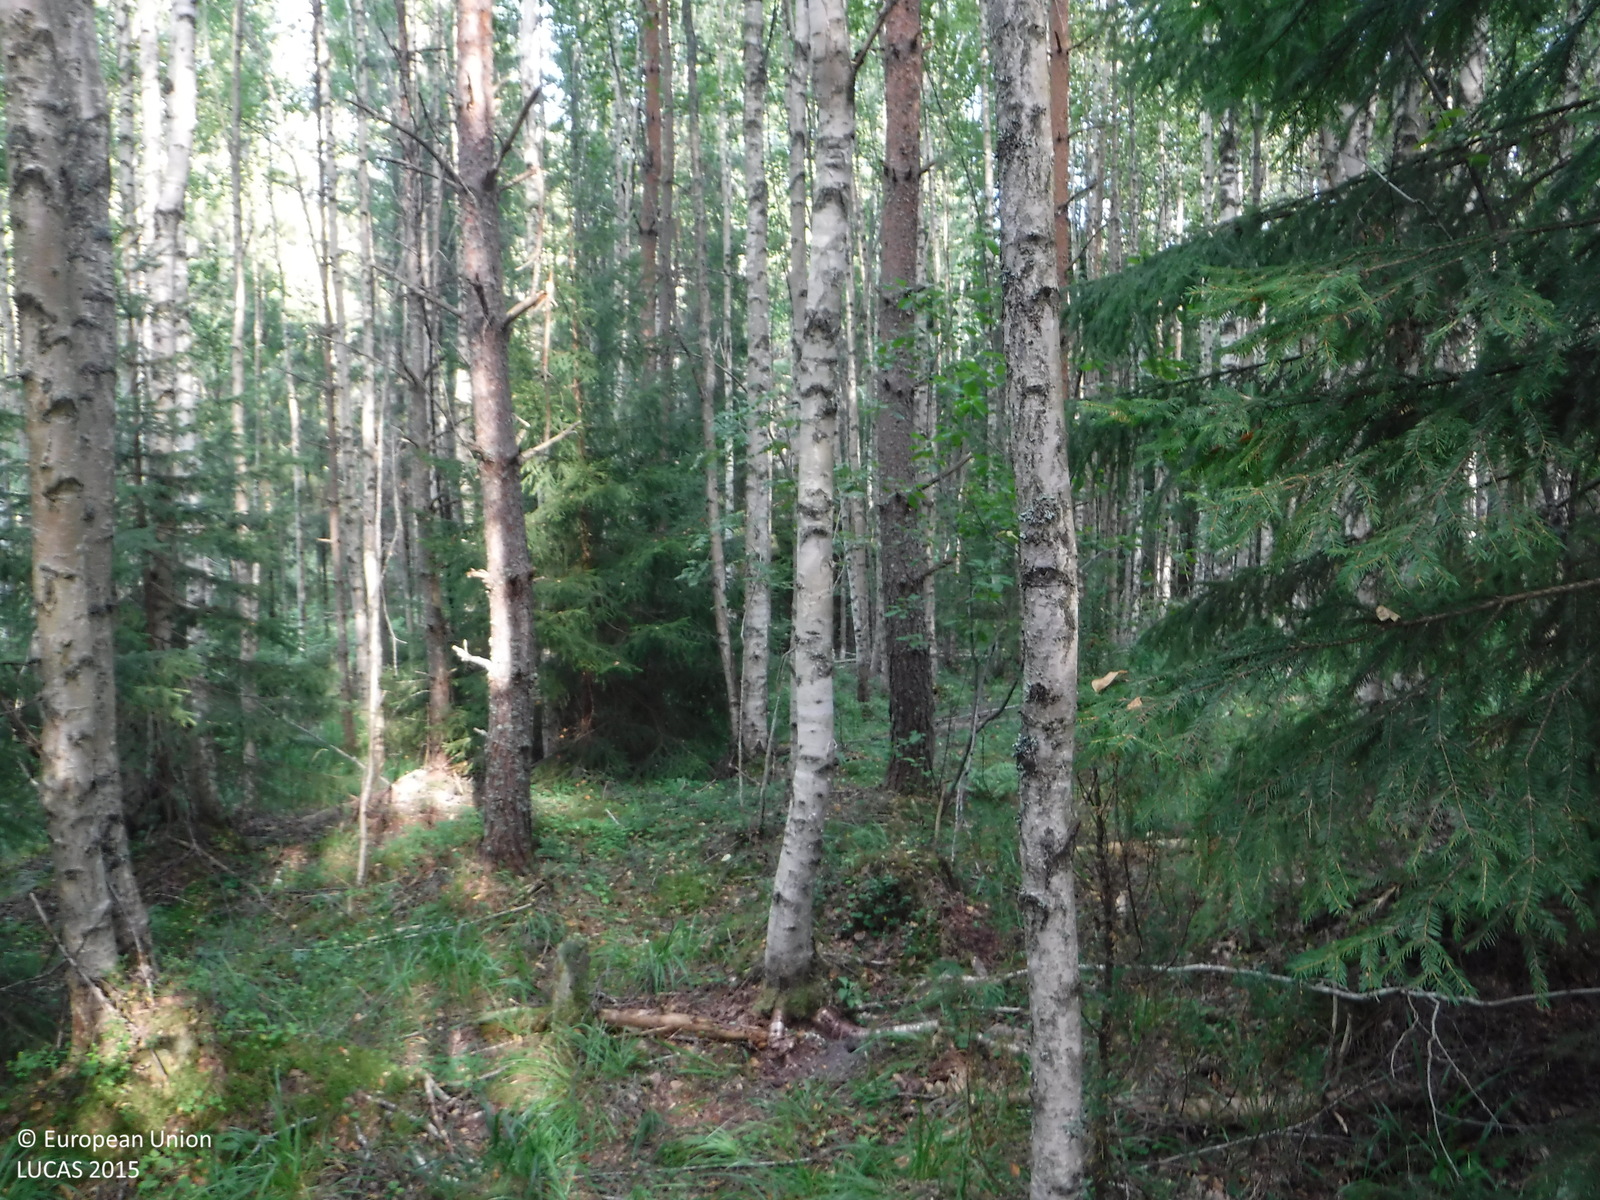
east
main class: Woodland
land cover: Other mixed woodland
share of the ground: 50 - 75 %
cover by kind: coniferous forest trees 40 %, broadleaved forest trees 30 %, herbaceous plants 20 %, lichens and mosses 10 %
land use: Forestry
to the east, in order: Other mixed woodland; Spruce dominated mixed woodland; Spruce dominated coniferous woodland; Ditches and canals; Shruby margins; Tracks; Grass margins; Spruce dominated coniferous woodland; Ditches and canals; Pine dominated mixed woodland; Other mixed woodland; Pine dominated coniferous woodland; Tracks; Pine dominated coniferous woodland; Other coniferous woodland
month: August
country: FI
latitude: 61.0883
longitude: 21.7940
